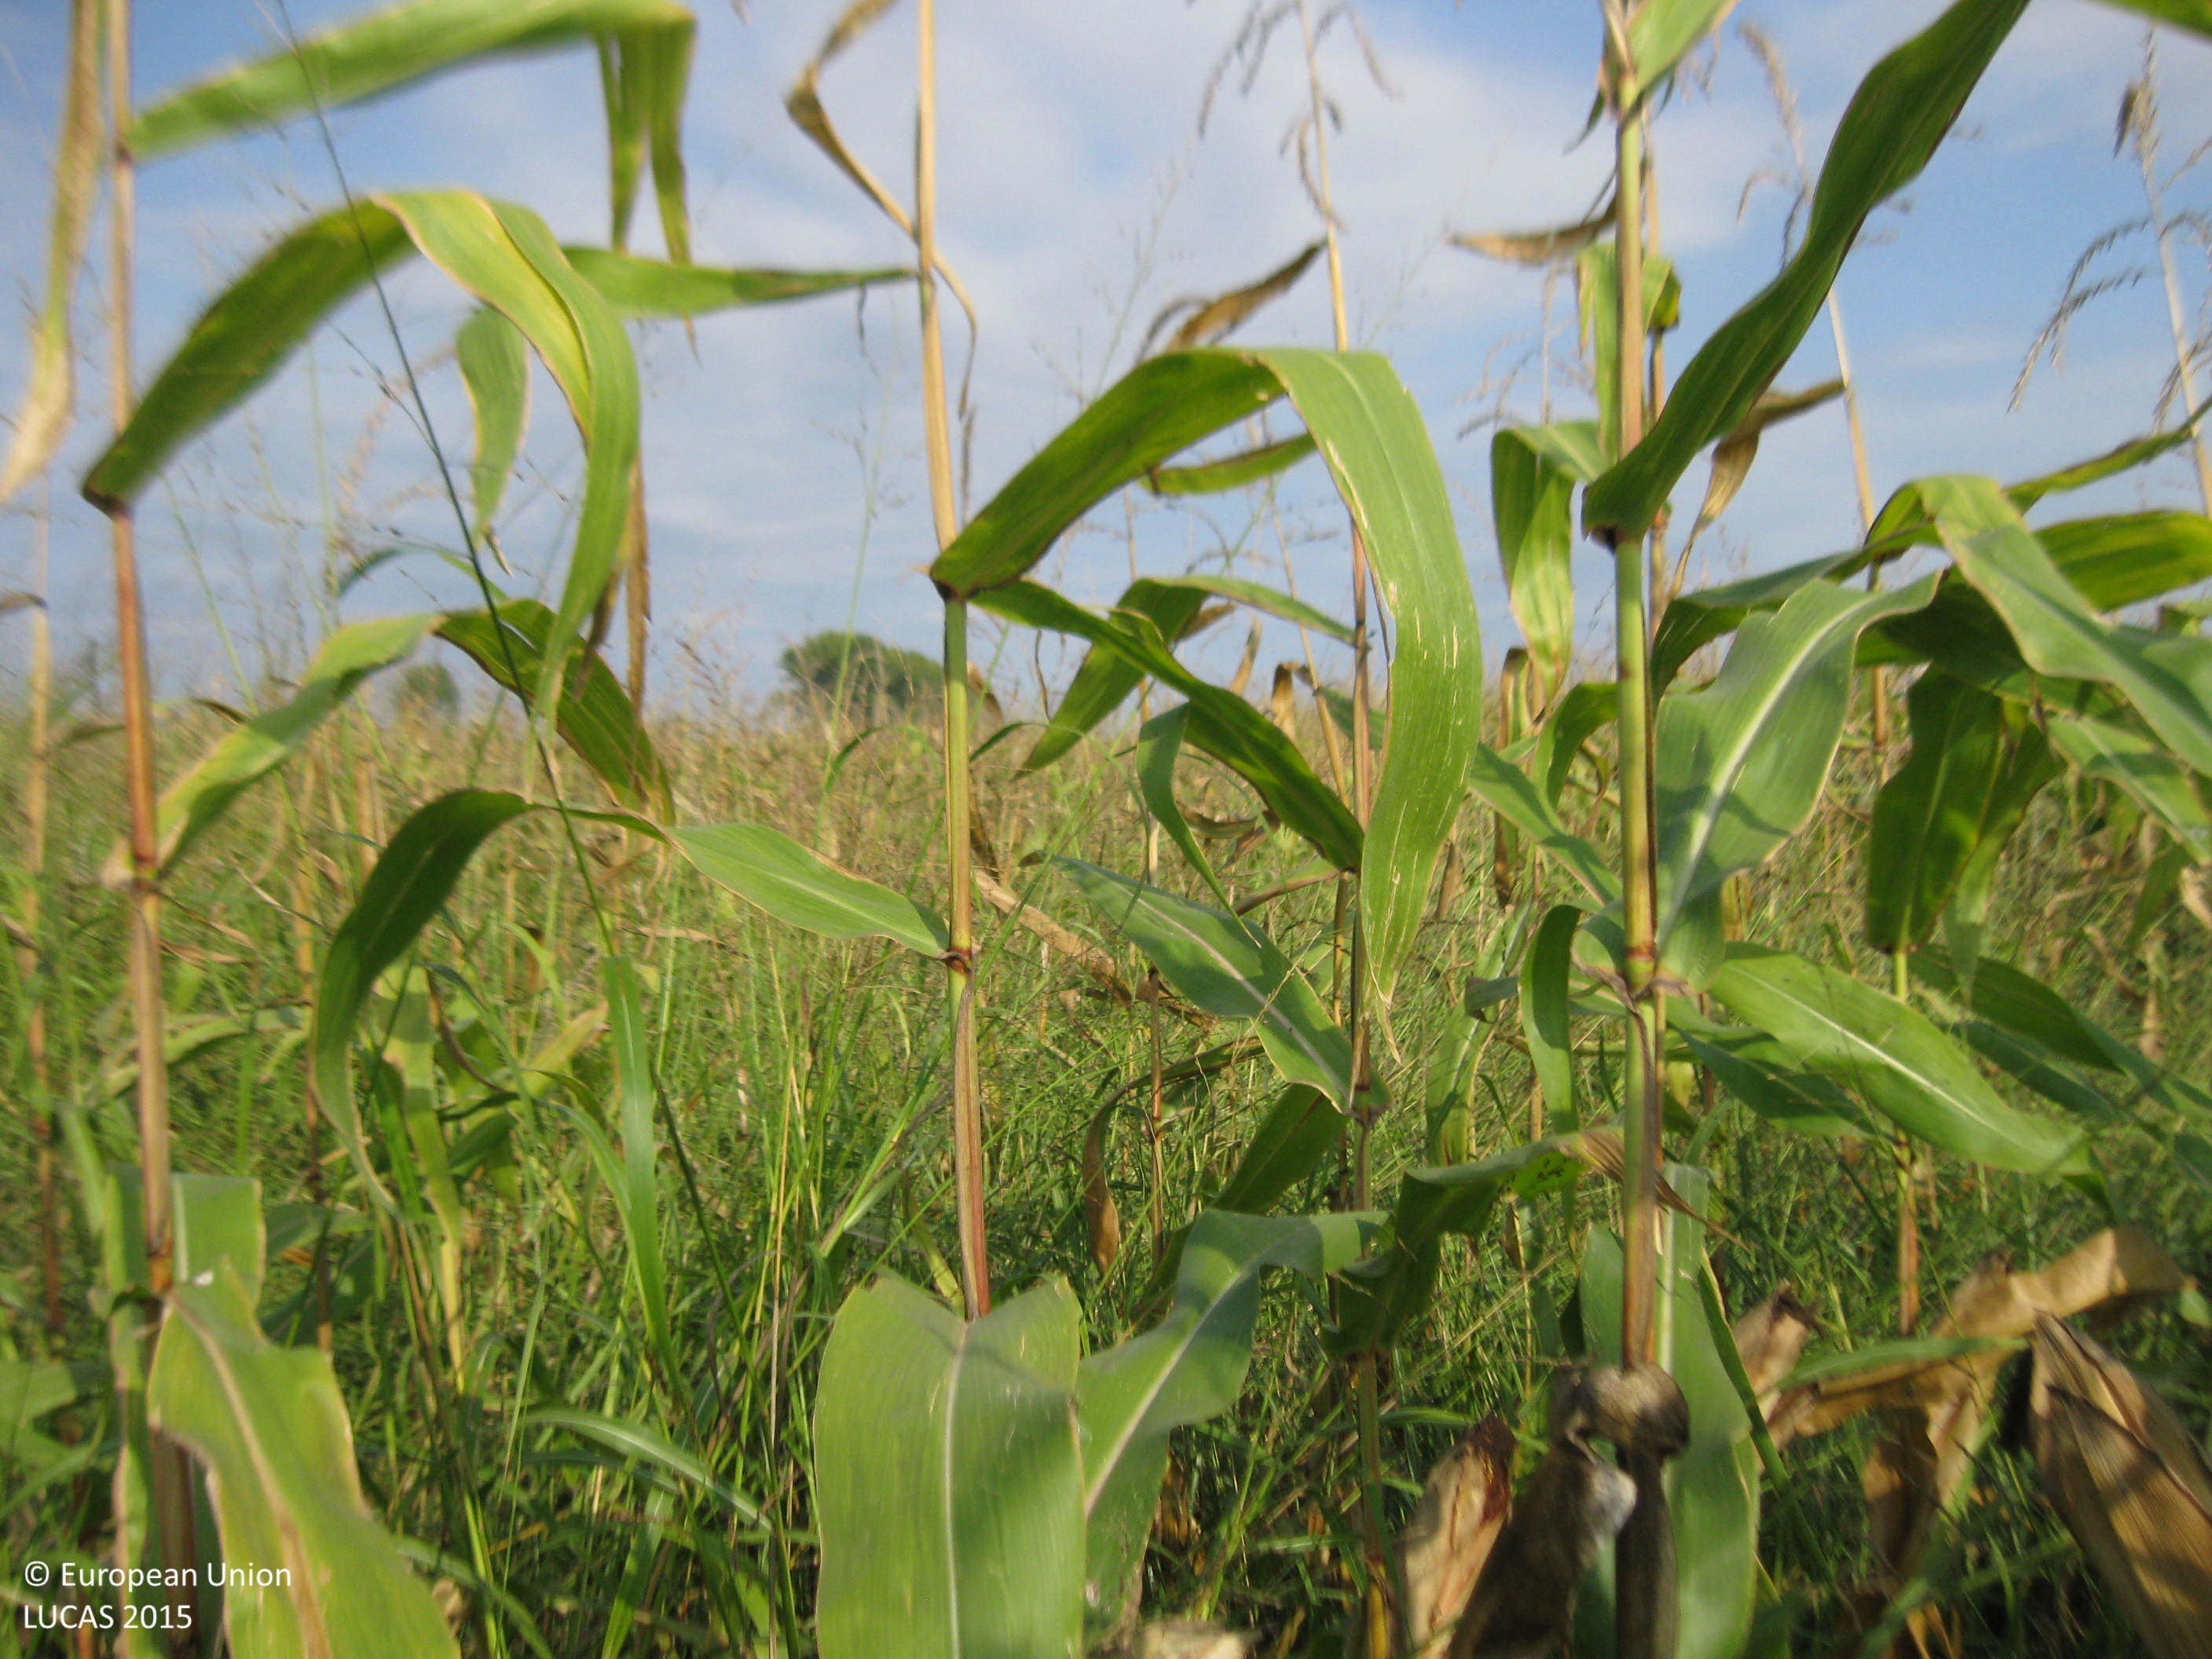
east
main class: Cropland
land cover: Maize
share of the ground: > 75 %
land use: Agriculture (excluding fallow land and kitchen gardens)
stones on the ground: < 10 %
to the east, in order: Maize; Spontaneously vegetated surfaces; Tracks; Grass margins; Other fresh vegetables; Ditches and canals; Tomatoes; Grass margins; Potatoes
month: September
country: BG
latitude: 42.1598
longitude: 25.0777
